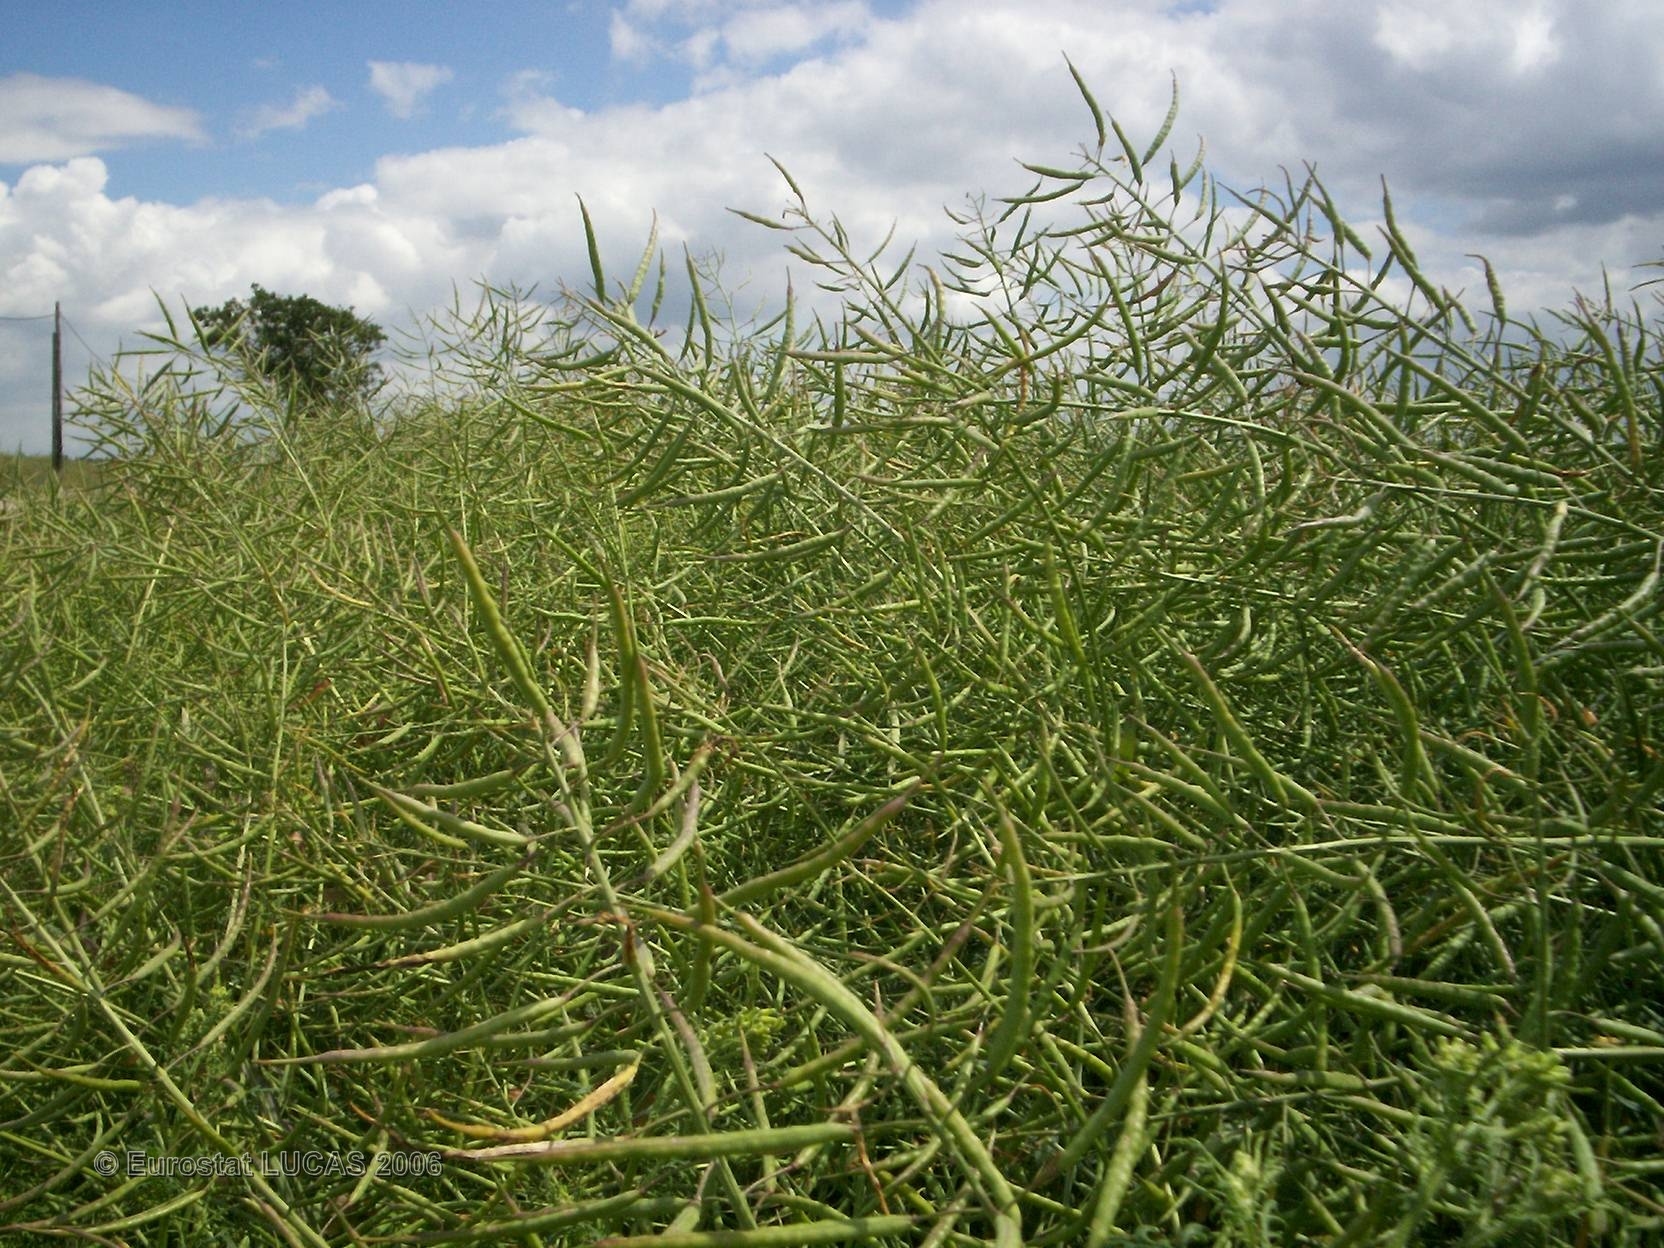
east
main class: Cropland
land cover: Rape and turnip rape
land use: Agriculture (excluding fallow land and kitchen gardens)
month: May
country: FR
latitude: 47.5842
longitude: -1.1412
